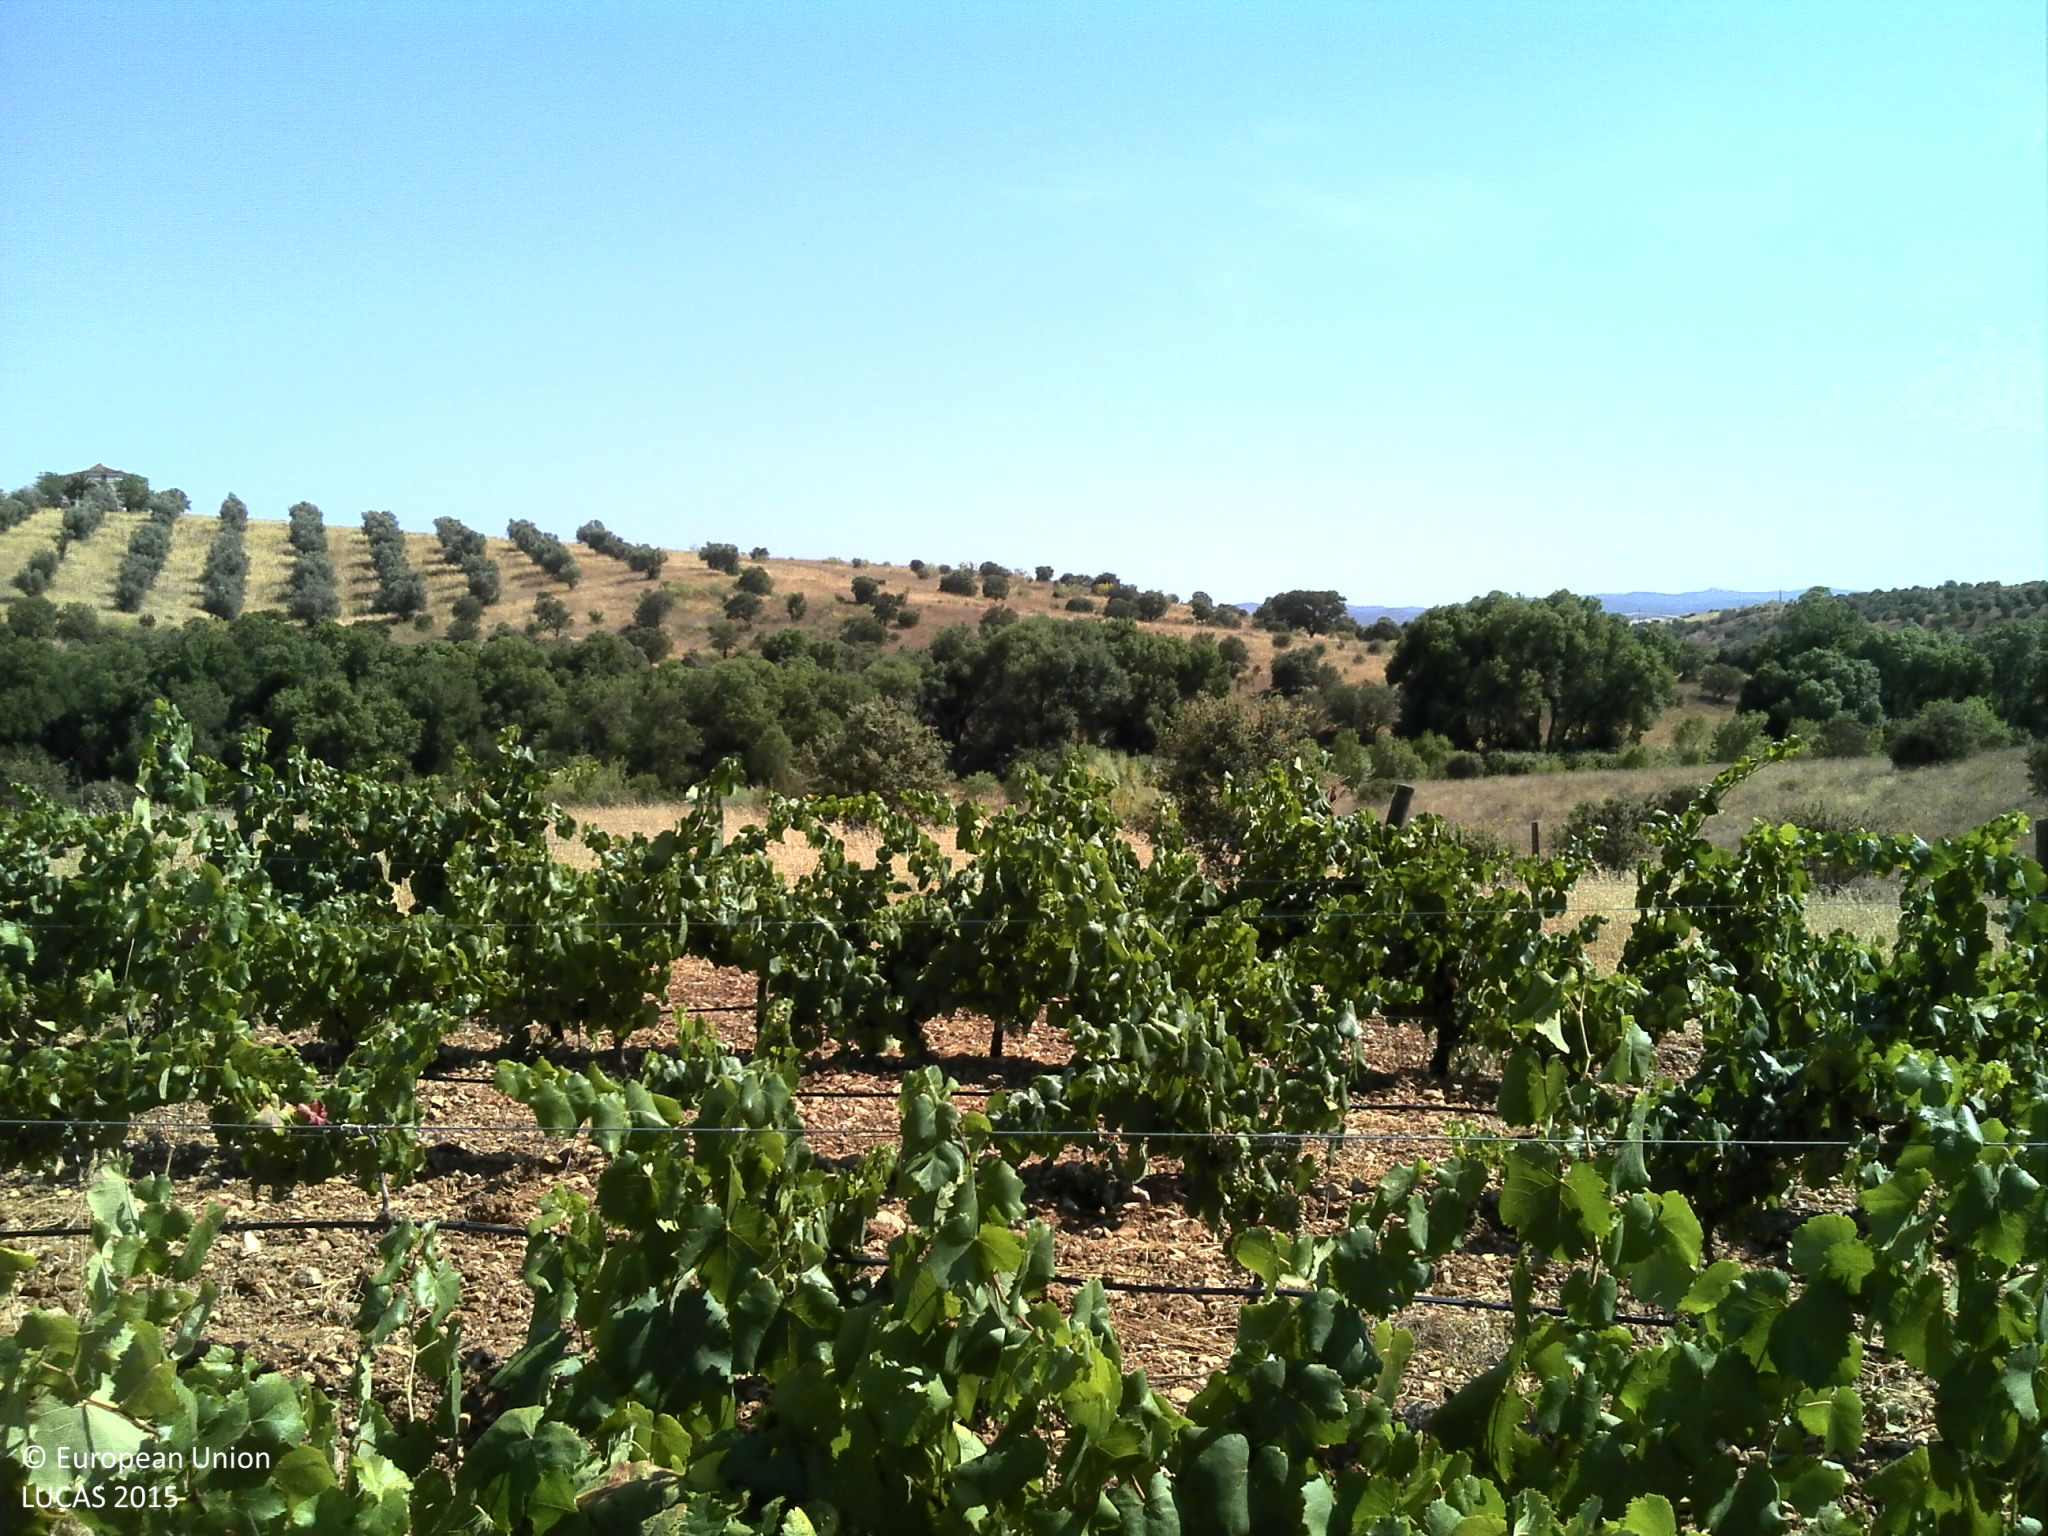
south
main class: Cropland
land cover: Vineyards
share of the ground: 25 - 50 %
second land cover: Other bare soil
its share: > 75 %
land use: Agriculture (excluding fallow land and kitchen gardens)
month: July
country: PT
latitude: 38.4291
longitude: -7.6604
